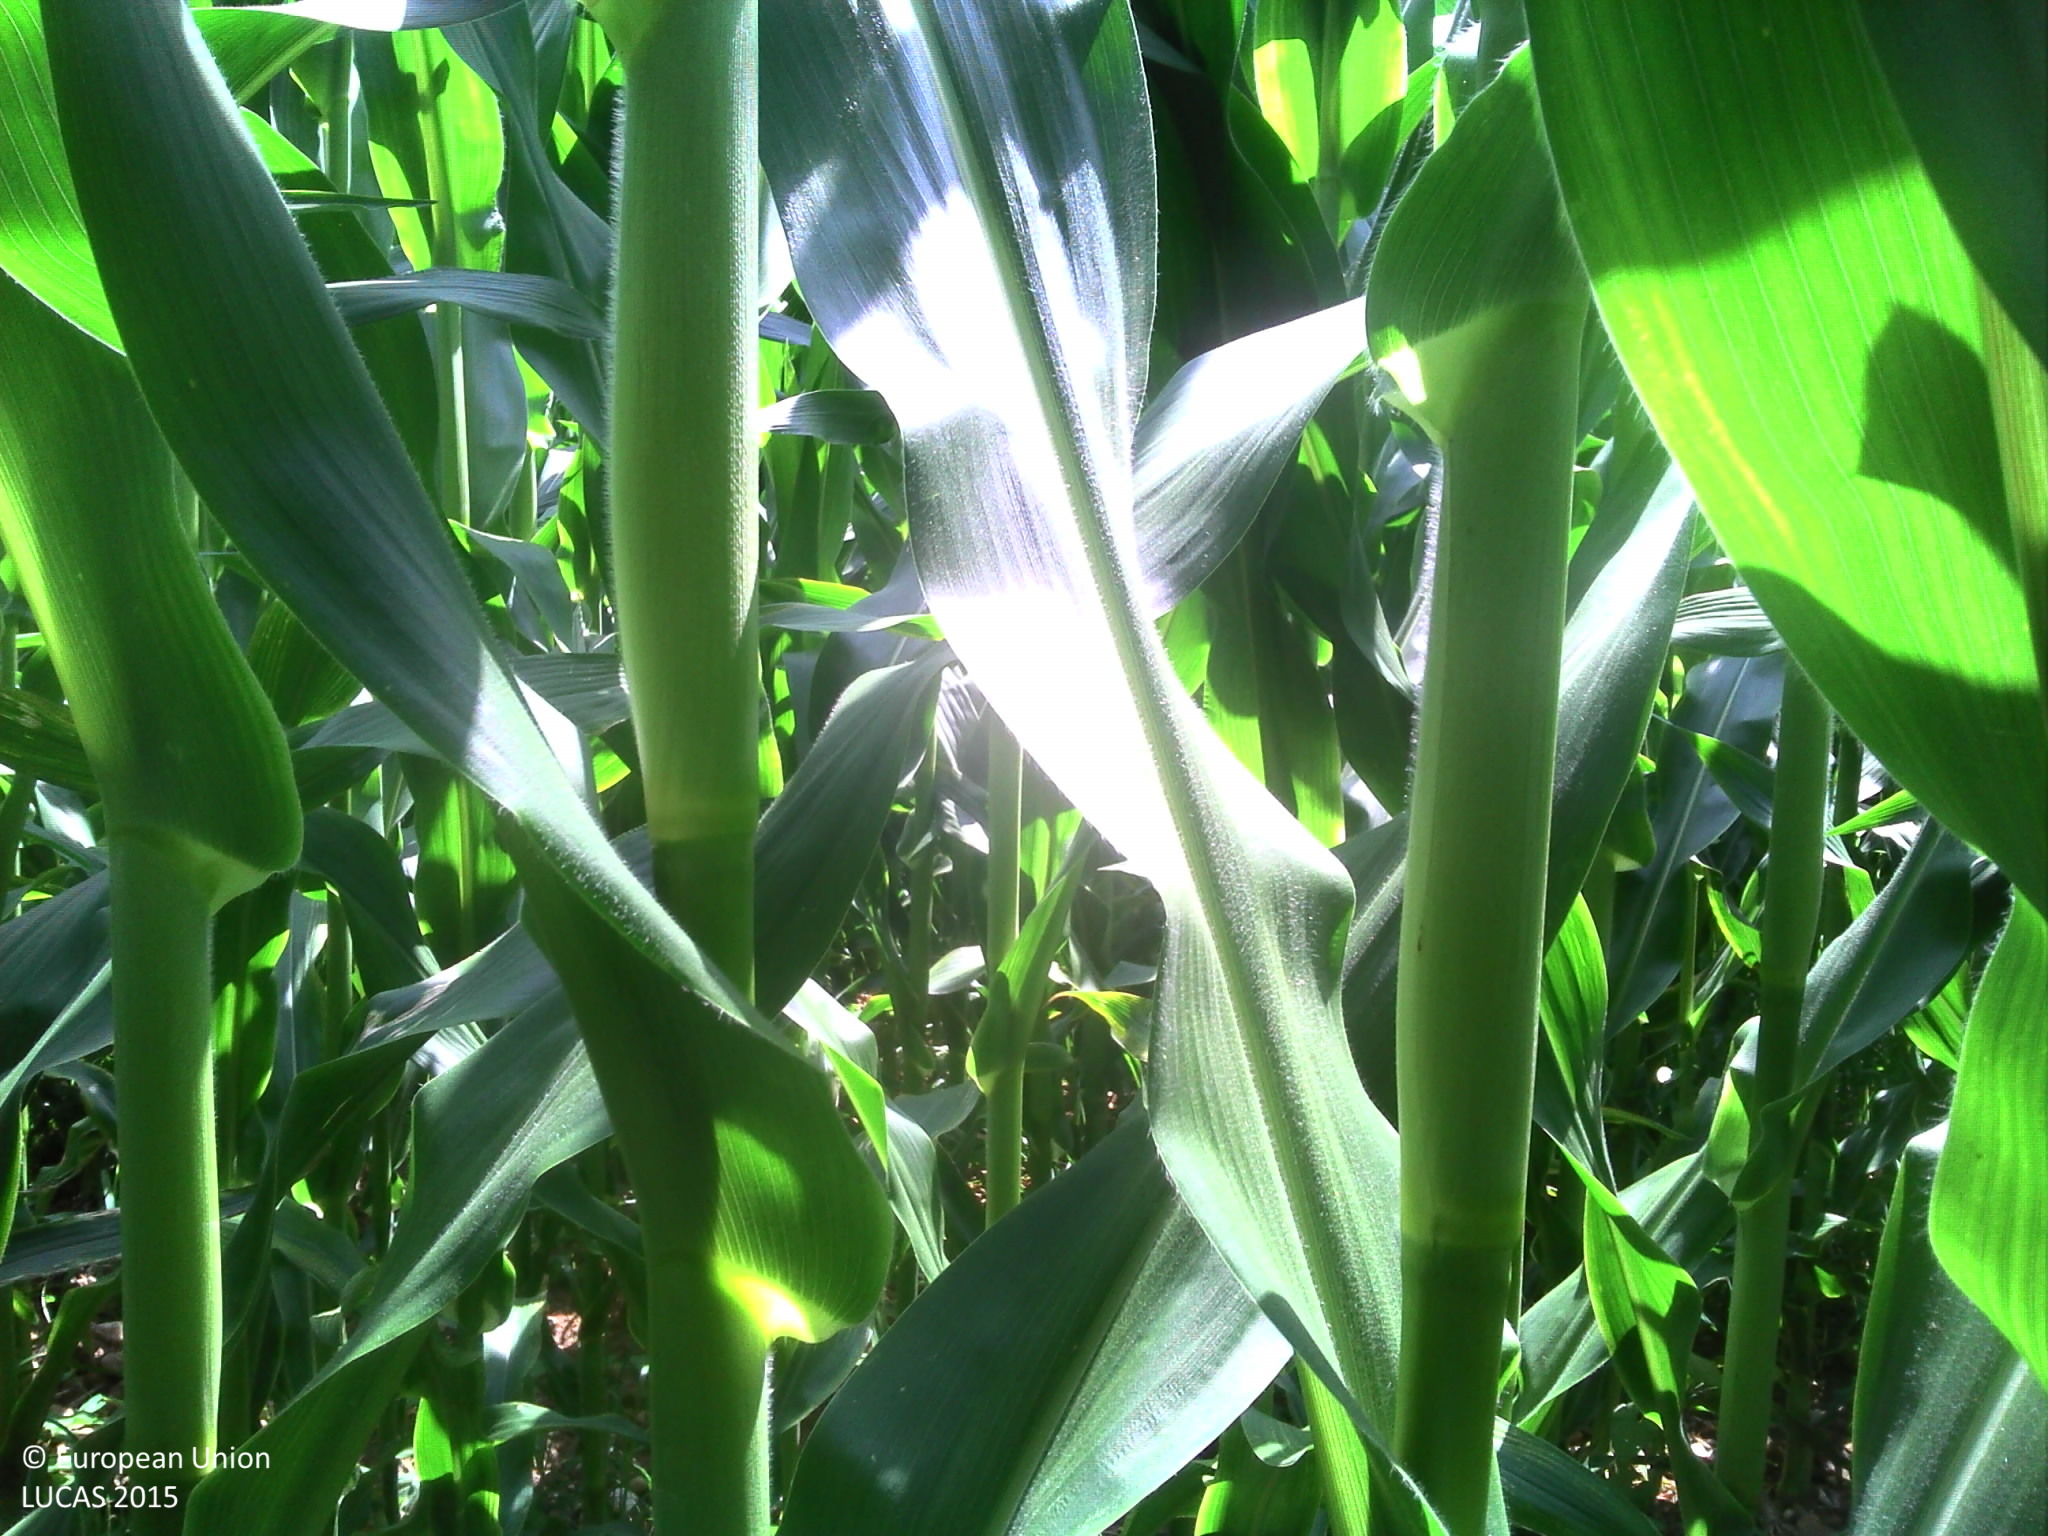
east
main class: Cropland
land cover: Maize
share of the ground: > 75 %
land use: Agriculture (excluding fallow land and kitchen gardens)
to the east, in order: Maize; Grass margins; Paved roads, cycling and walking lanes; Grass margins; Maize; Electric lines; Maize; Grass margins; Ditches and canals; Lines of trees; Fences; Grassland with sparse tree/shrub cover
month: July
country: FR
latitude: 45.8332
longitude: 5.3049
